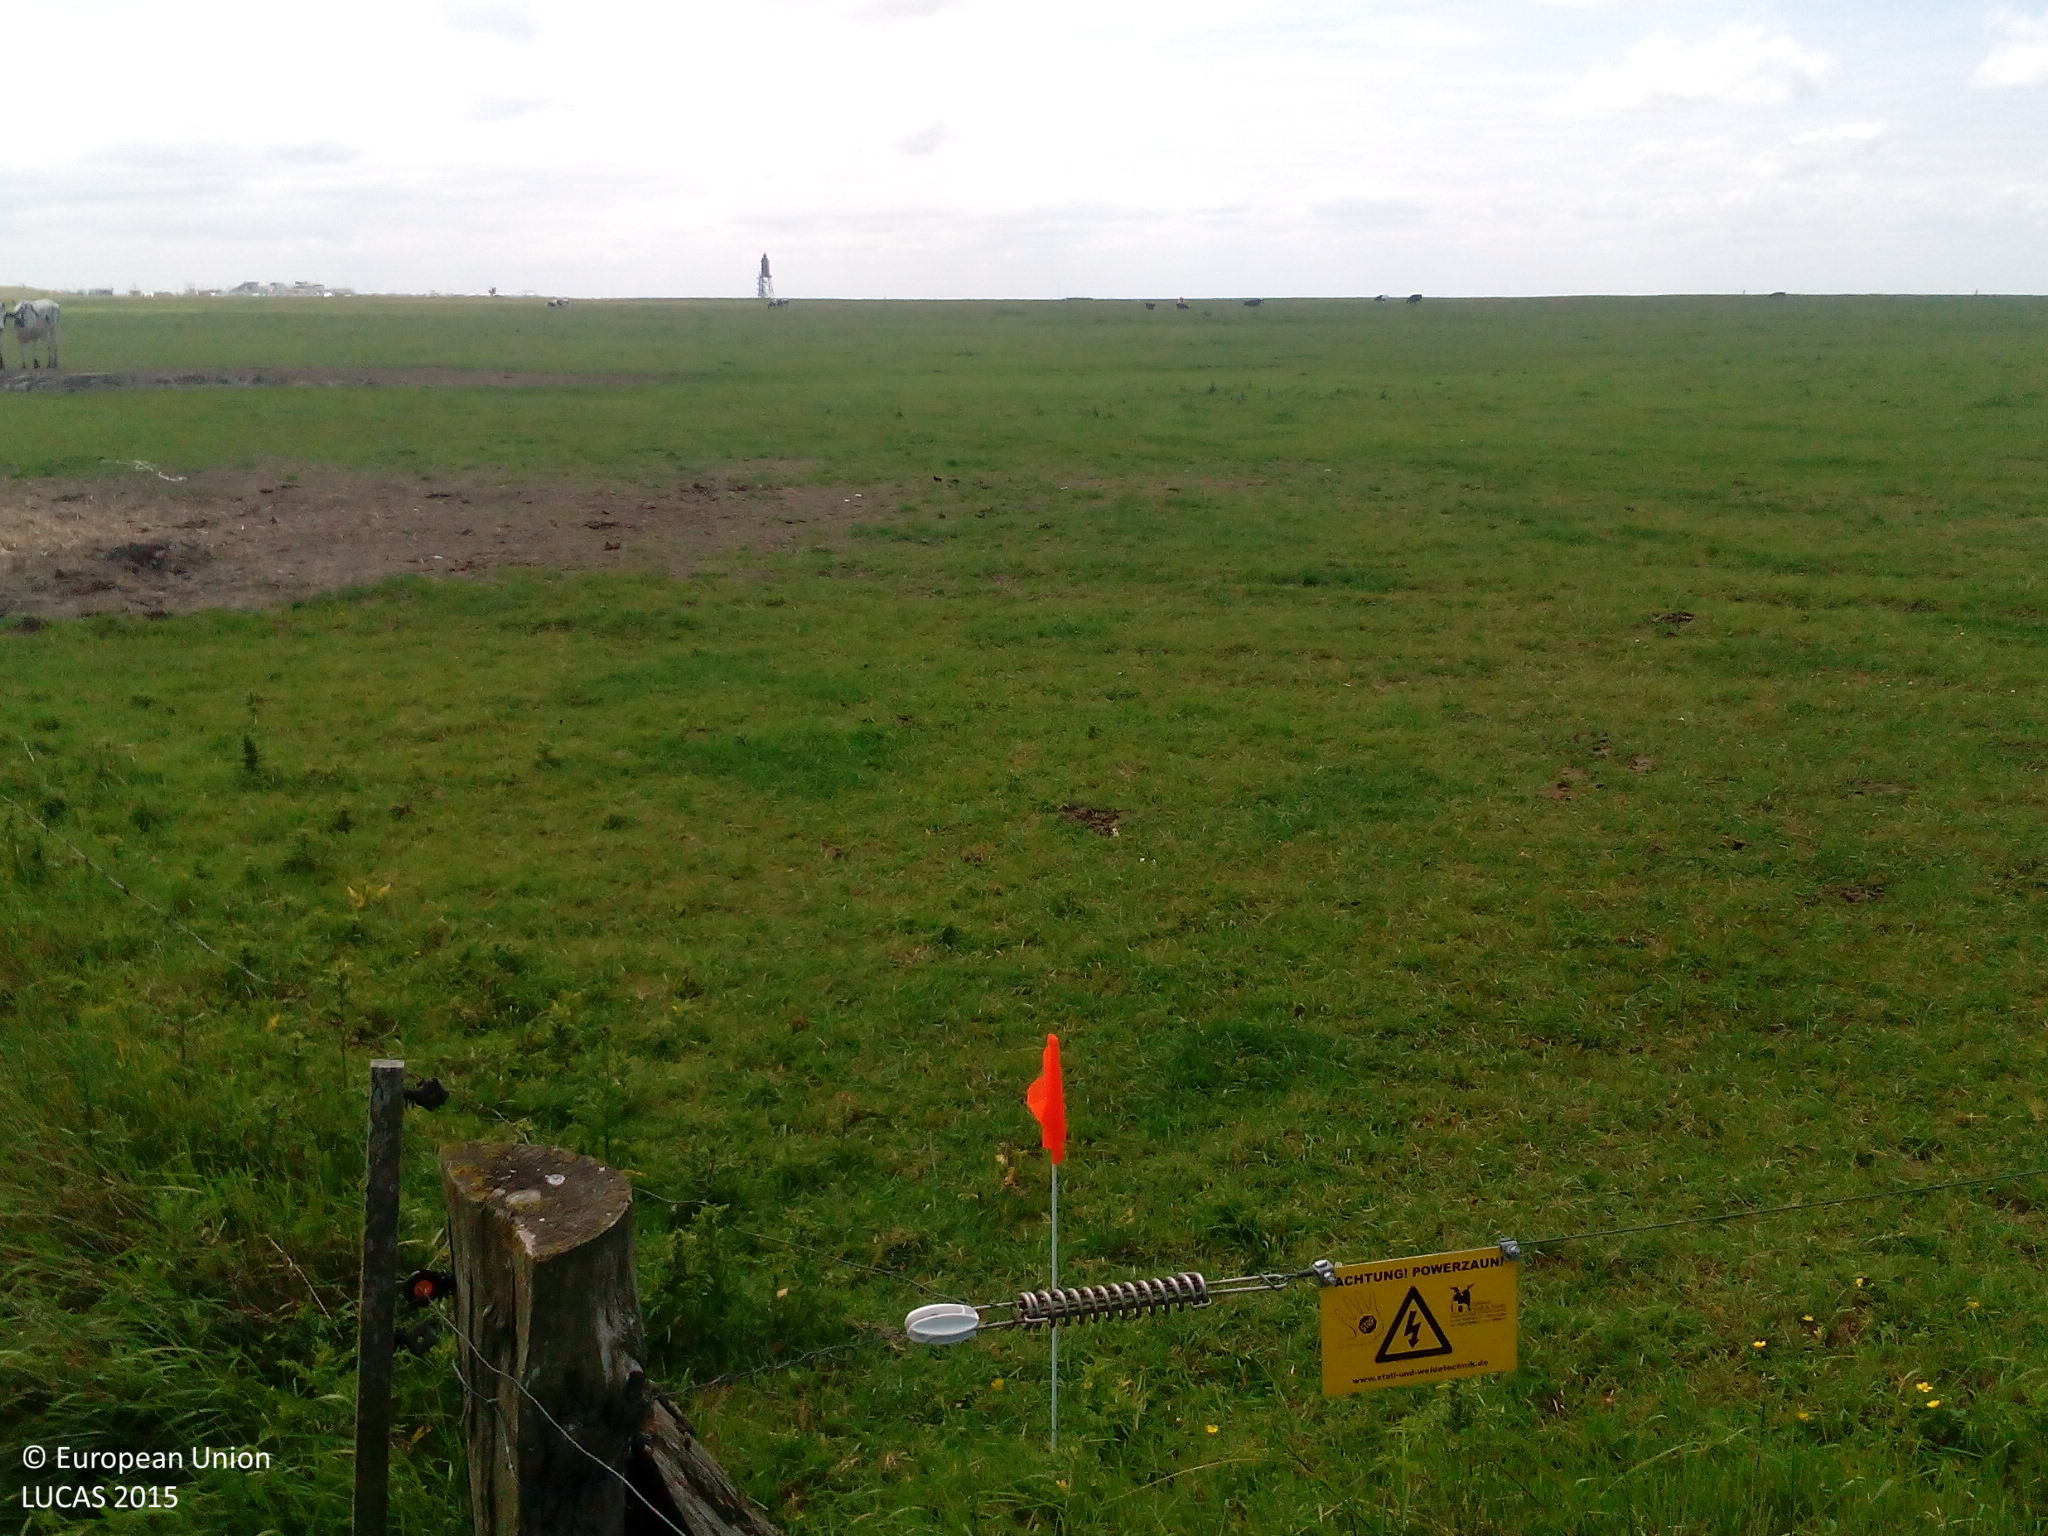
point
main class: Grassland
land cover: Grassland without tree/shrub cover
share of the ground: > 75 %
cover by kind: herbaceous plants 100 %
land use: Agriculture (excluding fallow land and kitchen gardens)
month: June
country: DE
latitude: 53.7525
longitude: 8.5296
